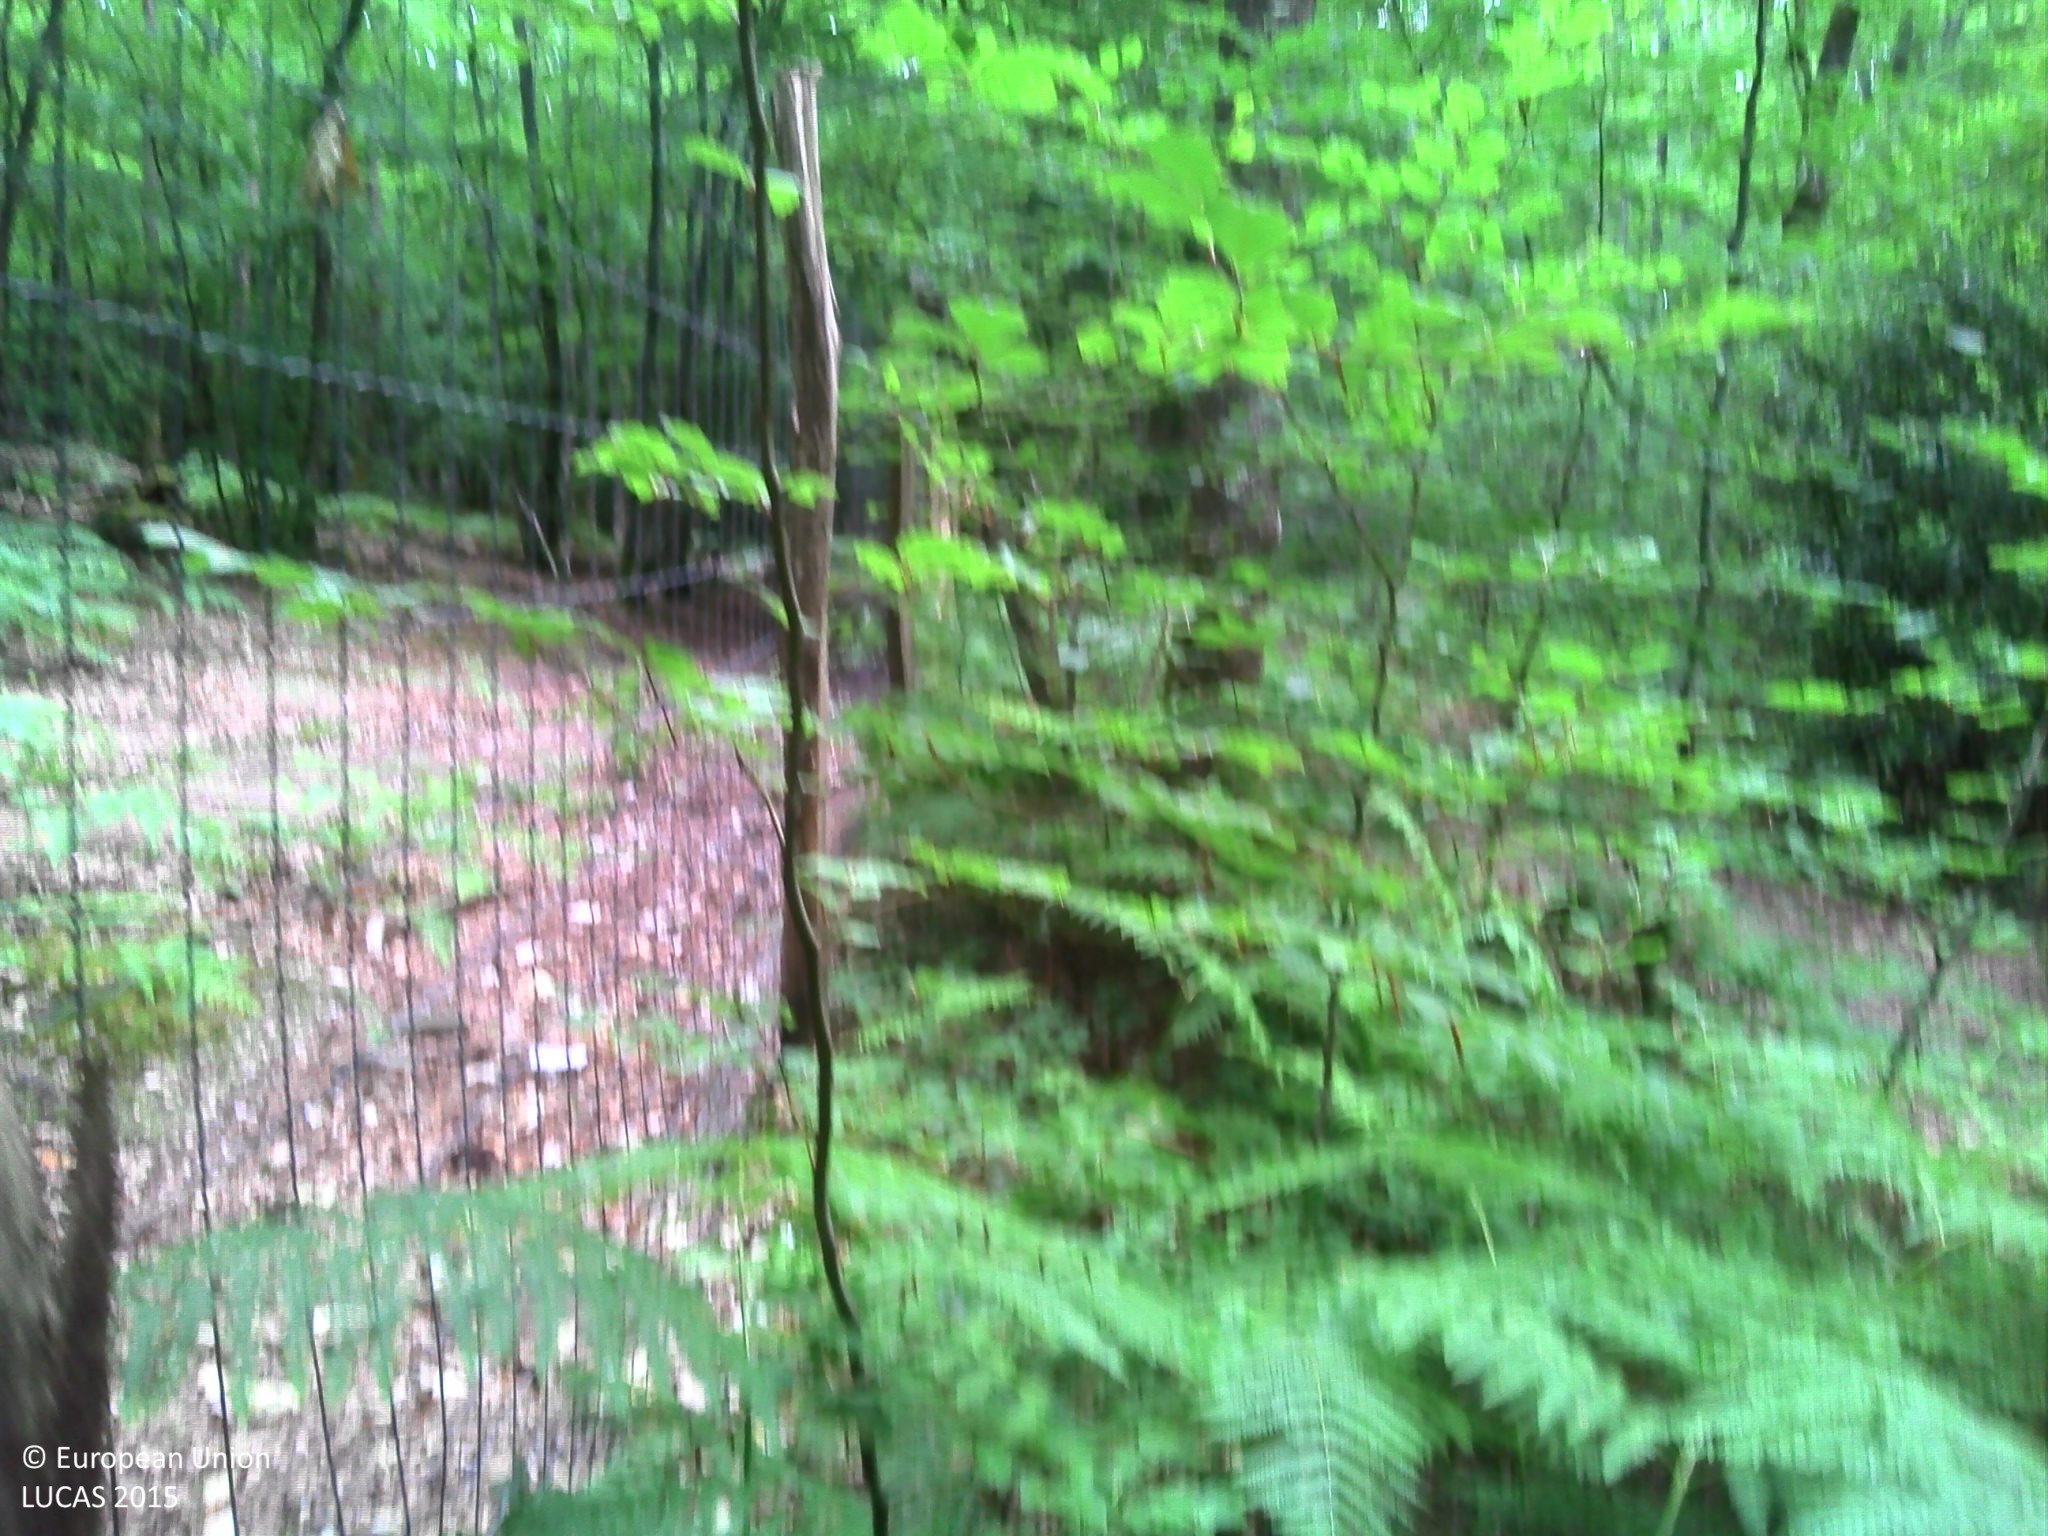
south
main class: Woodland
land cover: Broadleaved woodland
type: acidophilous oak and oak-birch forest
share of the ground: > 75 %
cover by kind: broadleaved forest trees 100 %
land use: Forestry
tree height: > 5 m
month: June
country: FR
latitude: 47.4134
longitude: 2.5839
